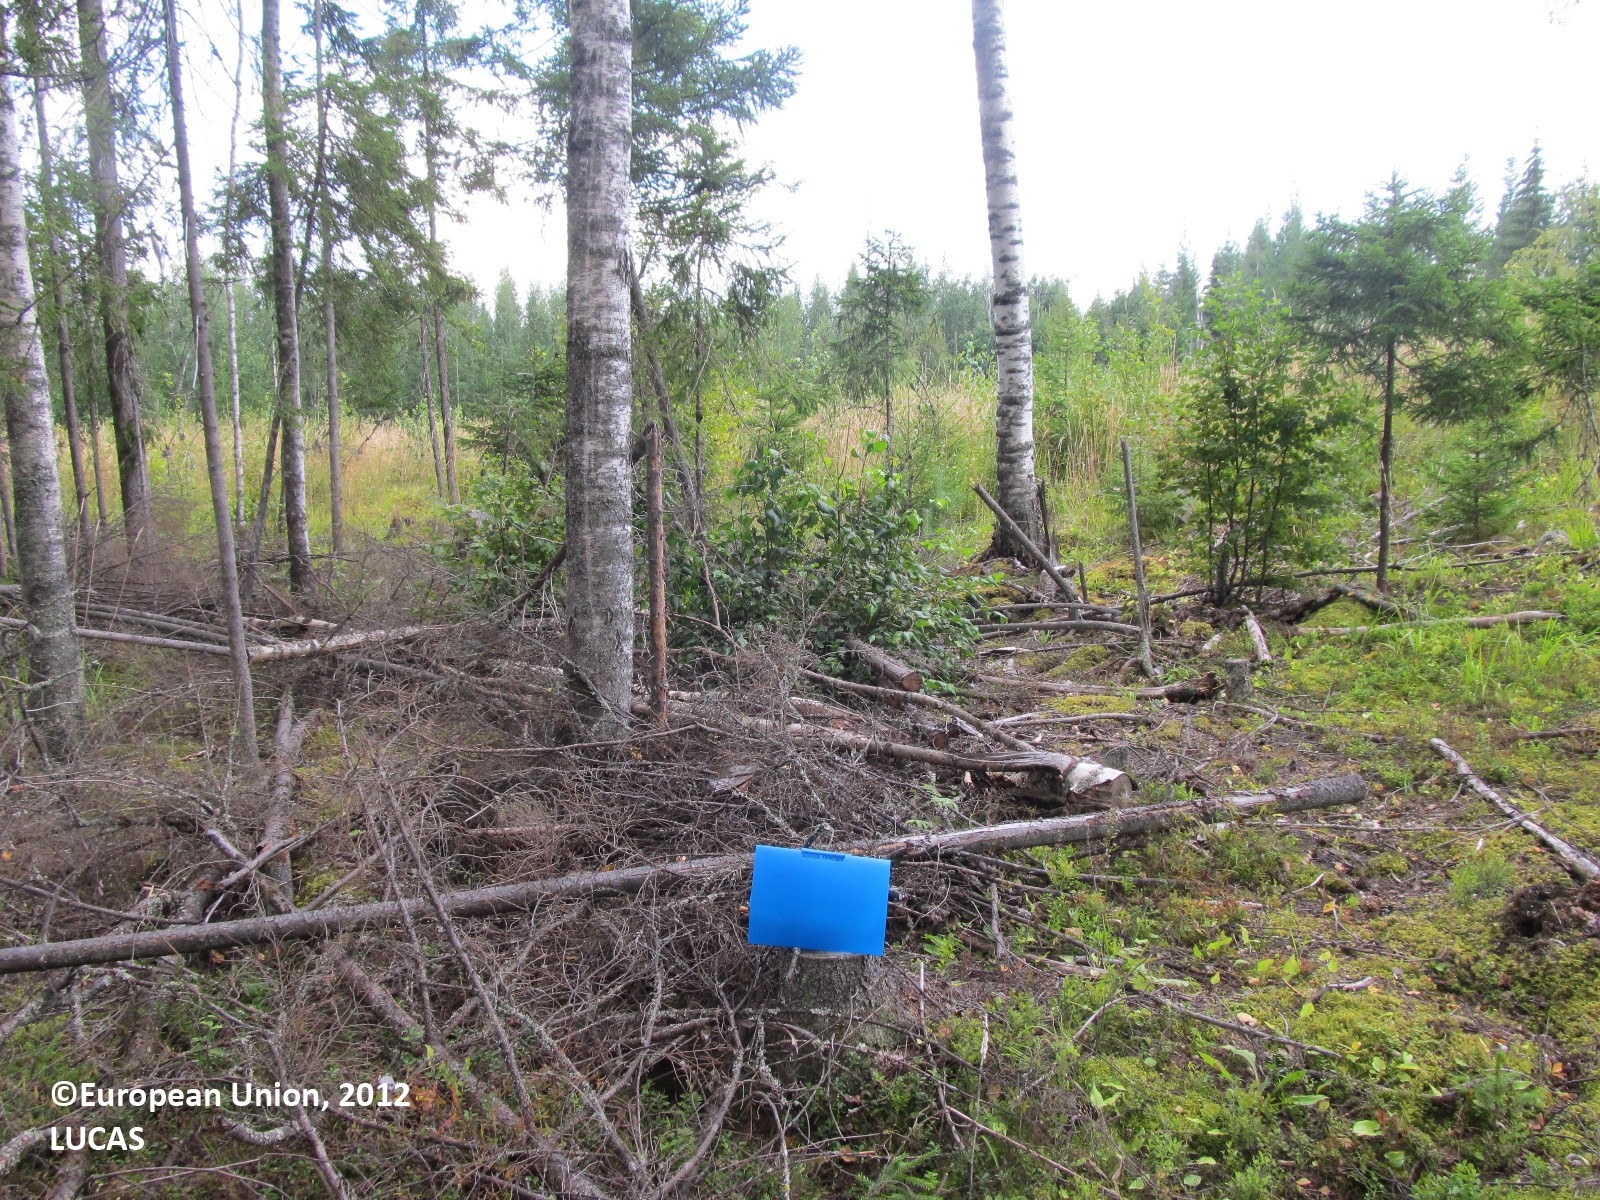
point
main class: Woodland
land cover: Spruce dominated mixed woodland
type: boreal forest
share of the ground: 25 - 50 %
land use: Forestry
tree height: > 5 m
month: August
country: FI
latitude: 62.4533
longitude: 27.7558
